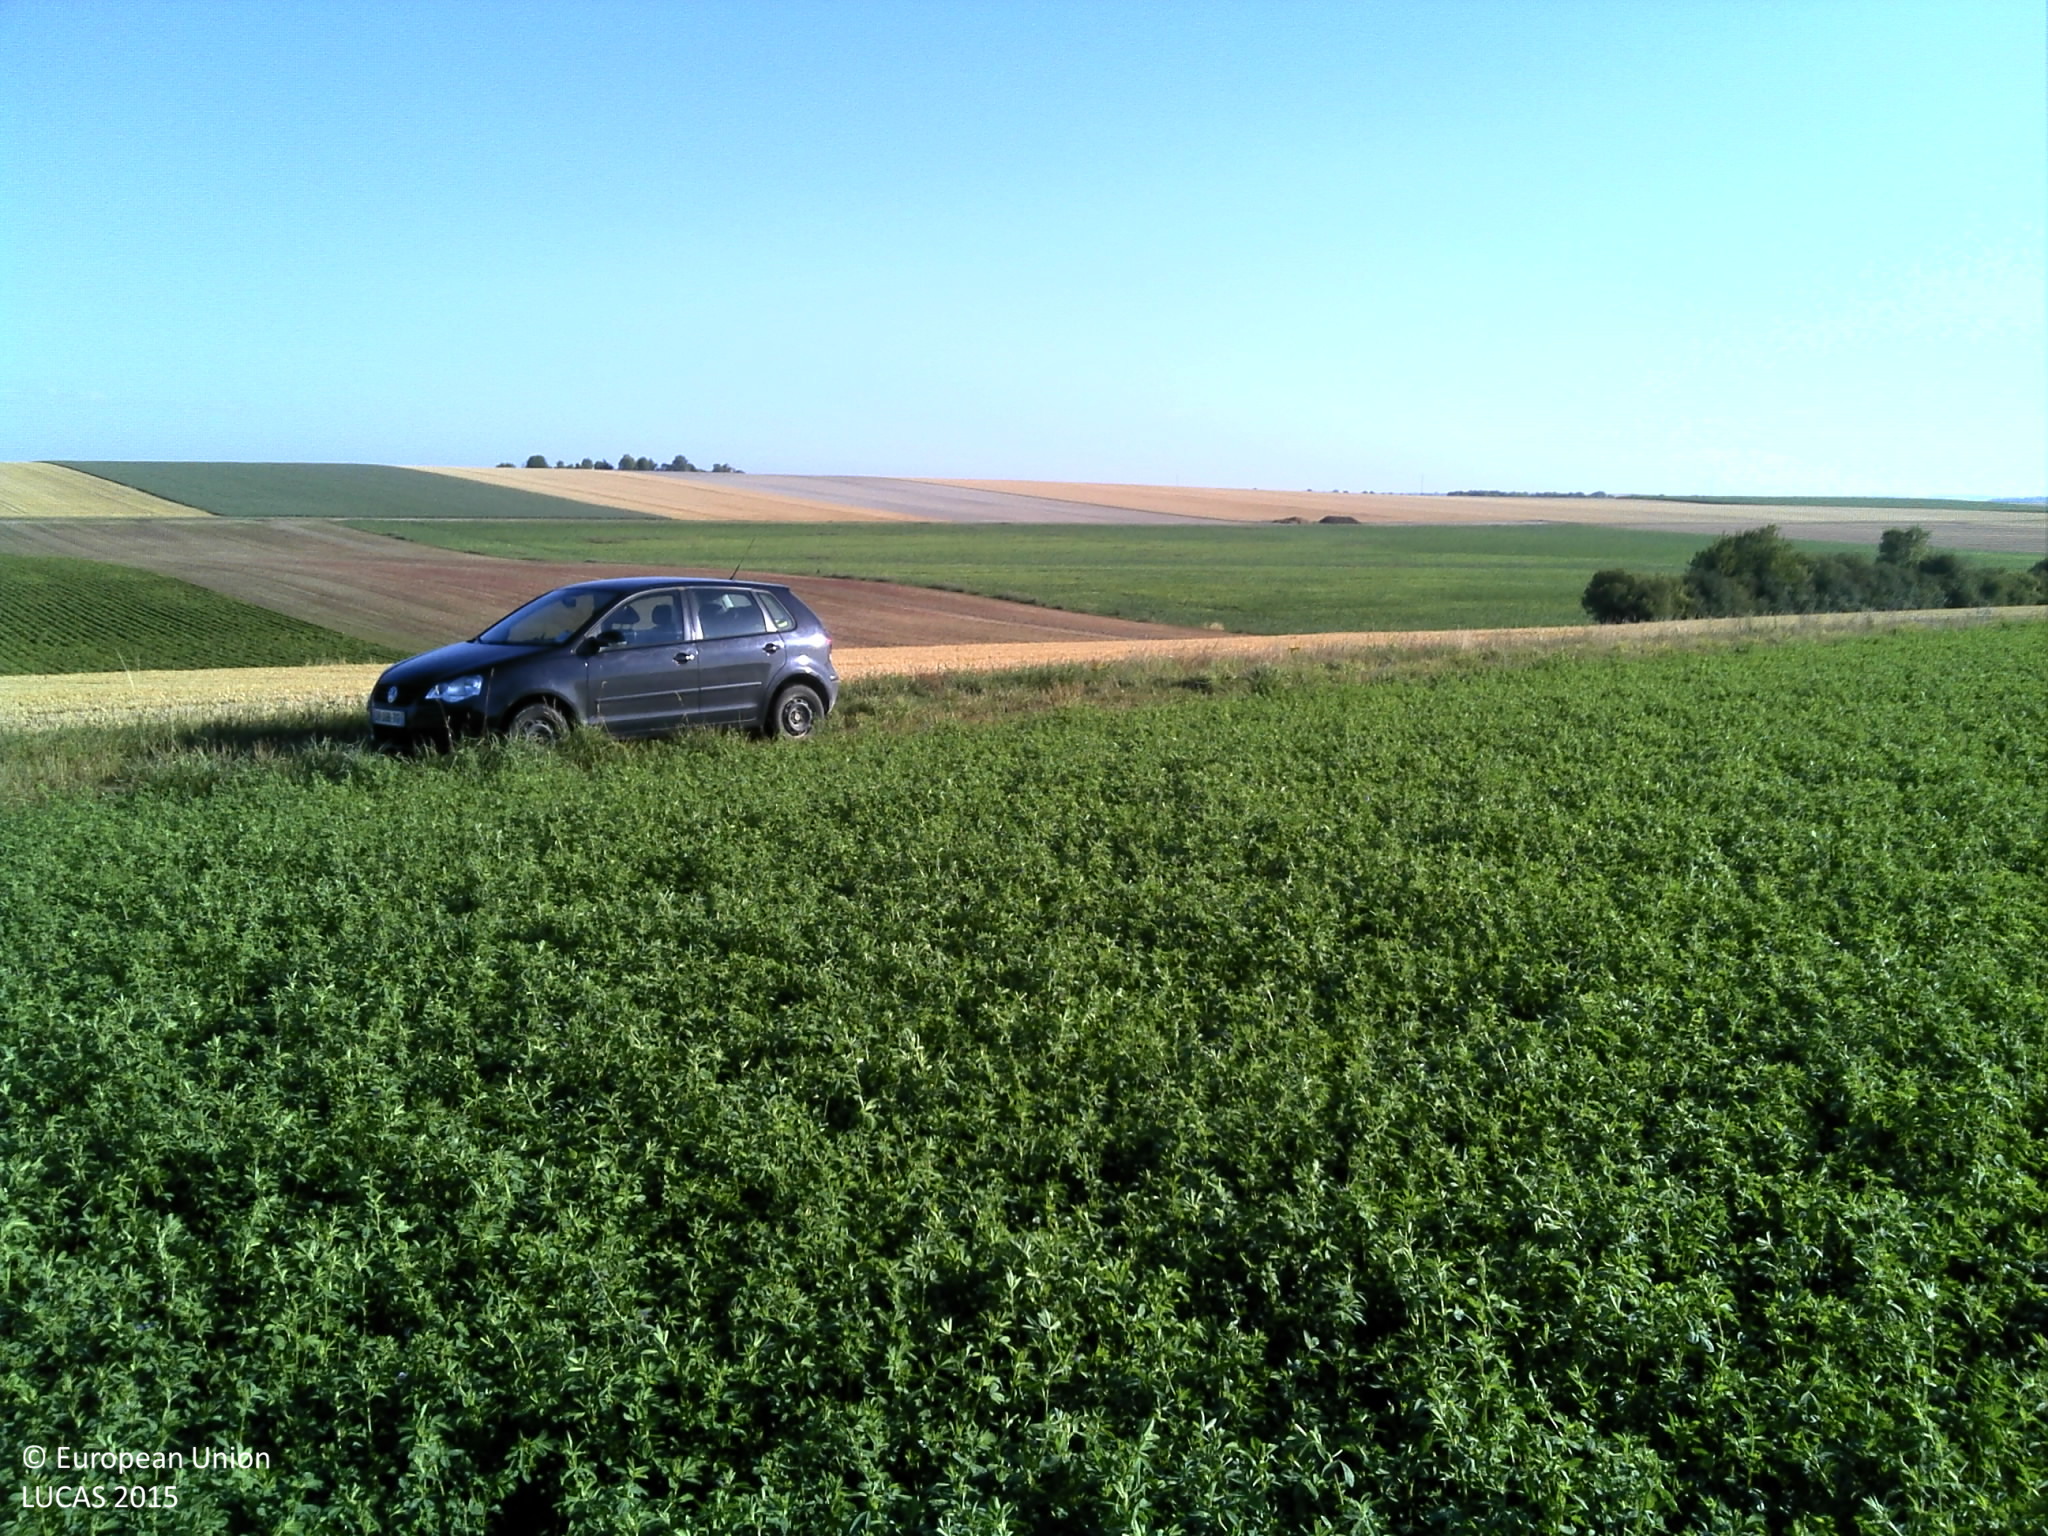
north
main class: Cropland
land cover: Lucerne
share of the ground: > 75 %
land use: Agriculture (excluding fallow land and kitchen gardens)
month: August
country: FR
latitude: 49.0850
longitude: 4.6433
